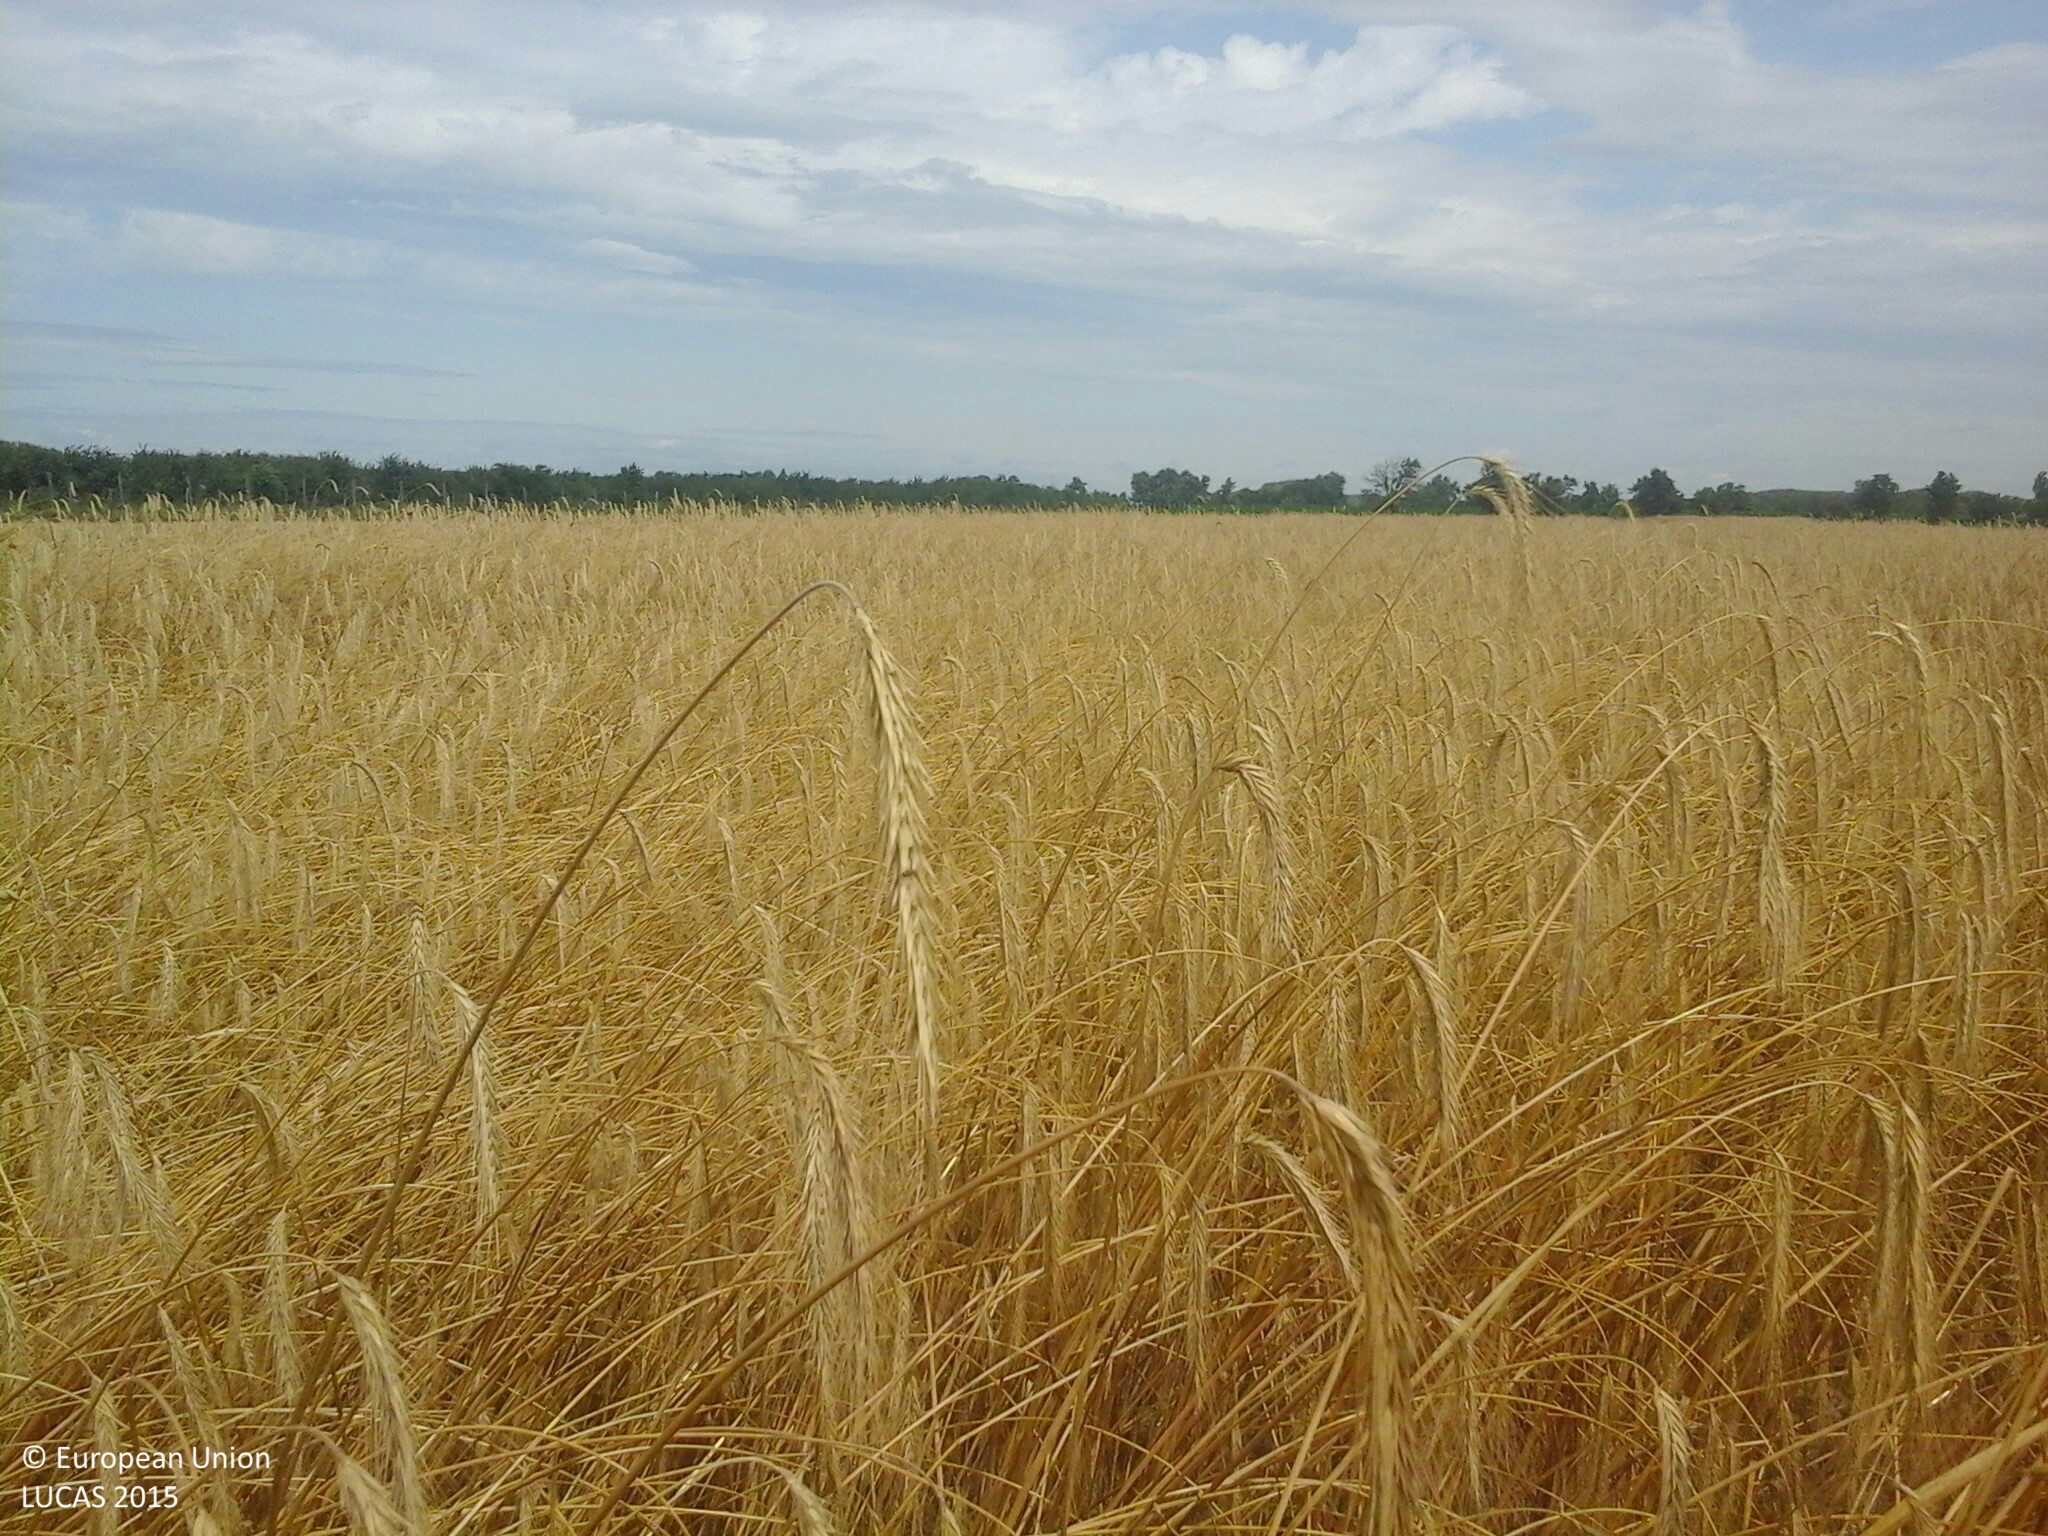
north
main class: Cropland
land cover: Rye
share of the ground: > 75 %
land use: Agriculture (excluding fallow land and kitchen gardens)
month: July
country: HU
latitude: 47.1867
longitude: 18.9769
